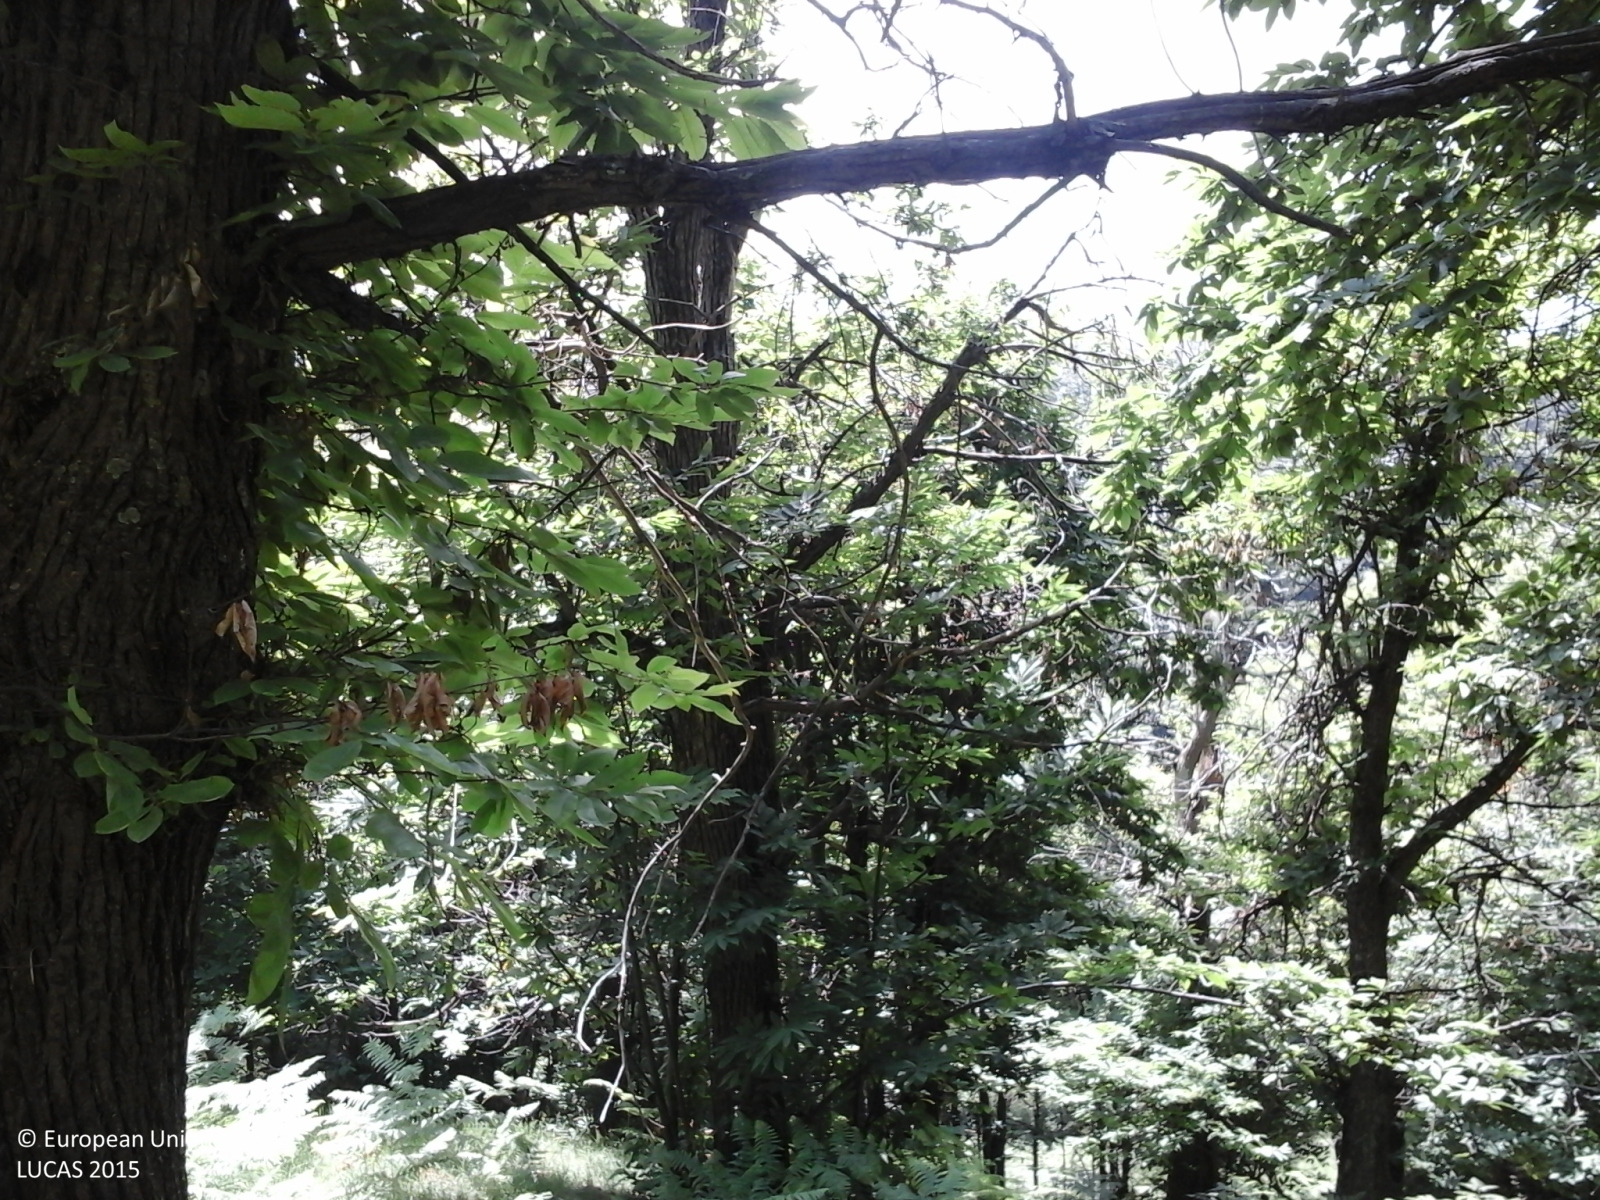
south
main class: Woodland
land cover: Broadleaved woodland
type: thermophilous deciduous forest
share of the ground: > 75 %
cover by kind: broadleaved forest trees 100 %
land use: Semi-natural and natural areas not in use
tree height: > 5 m
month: June
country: IT
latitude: 44.3084
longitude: 7.7609
